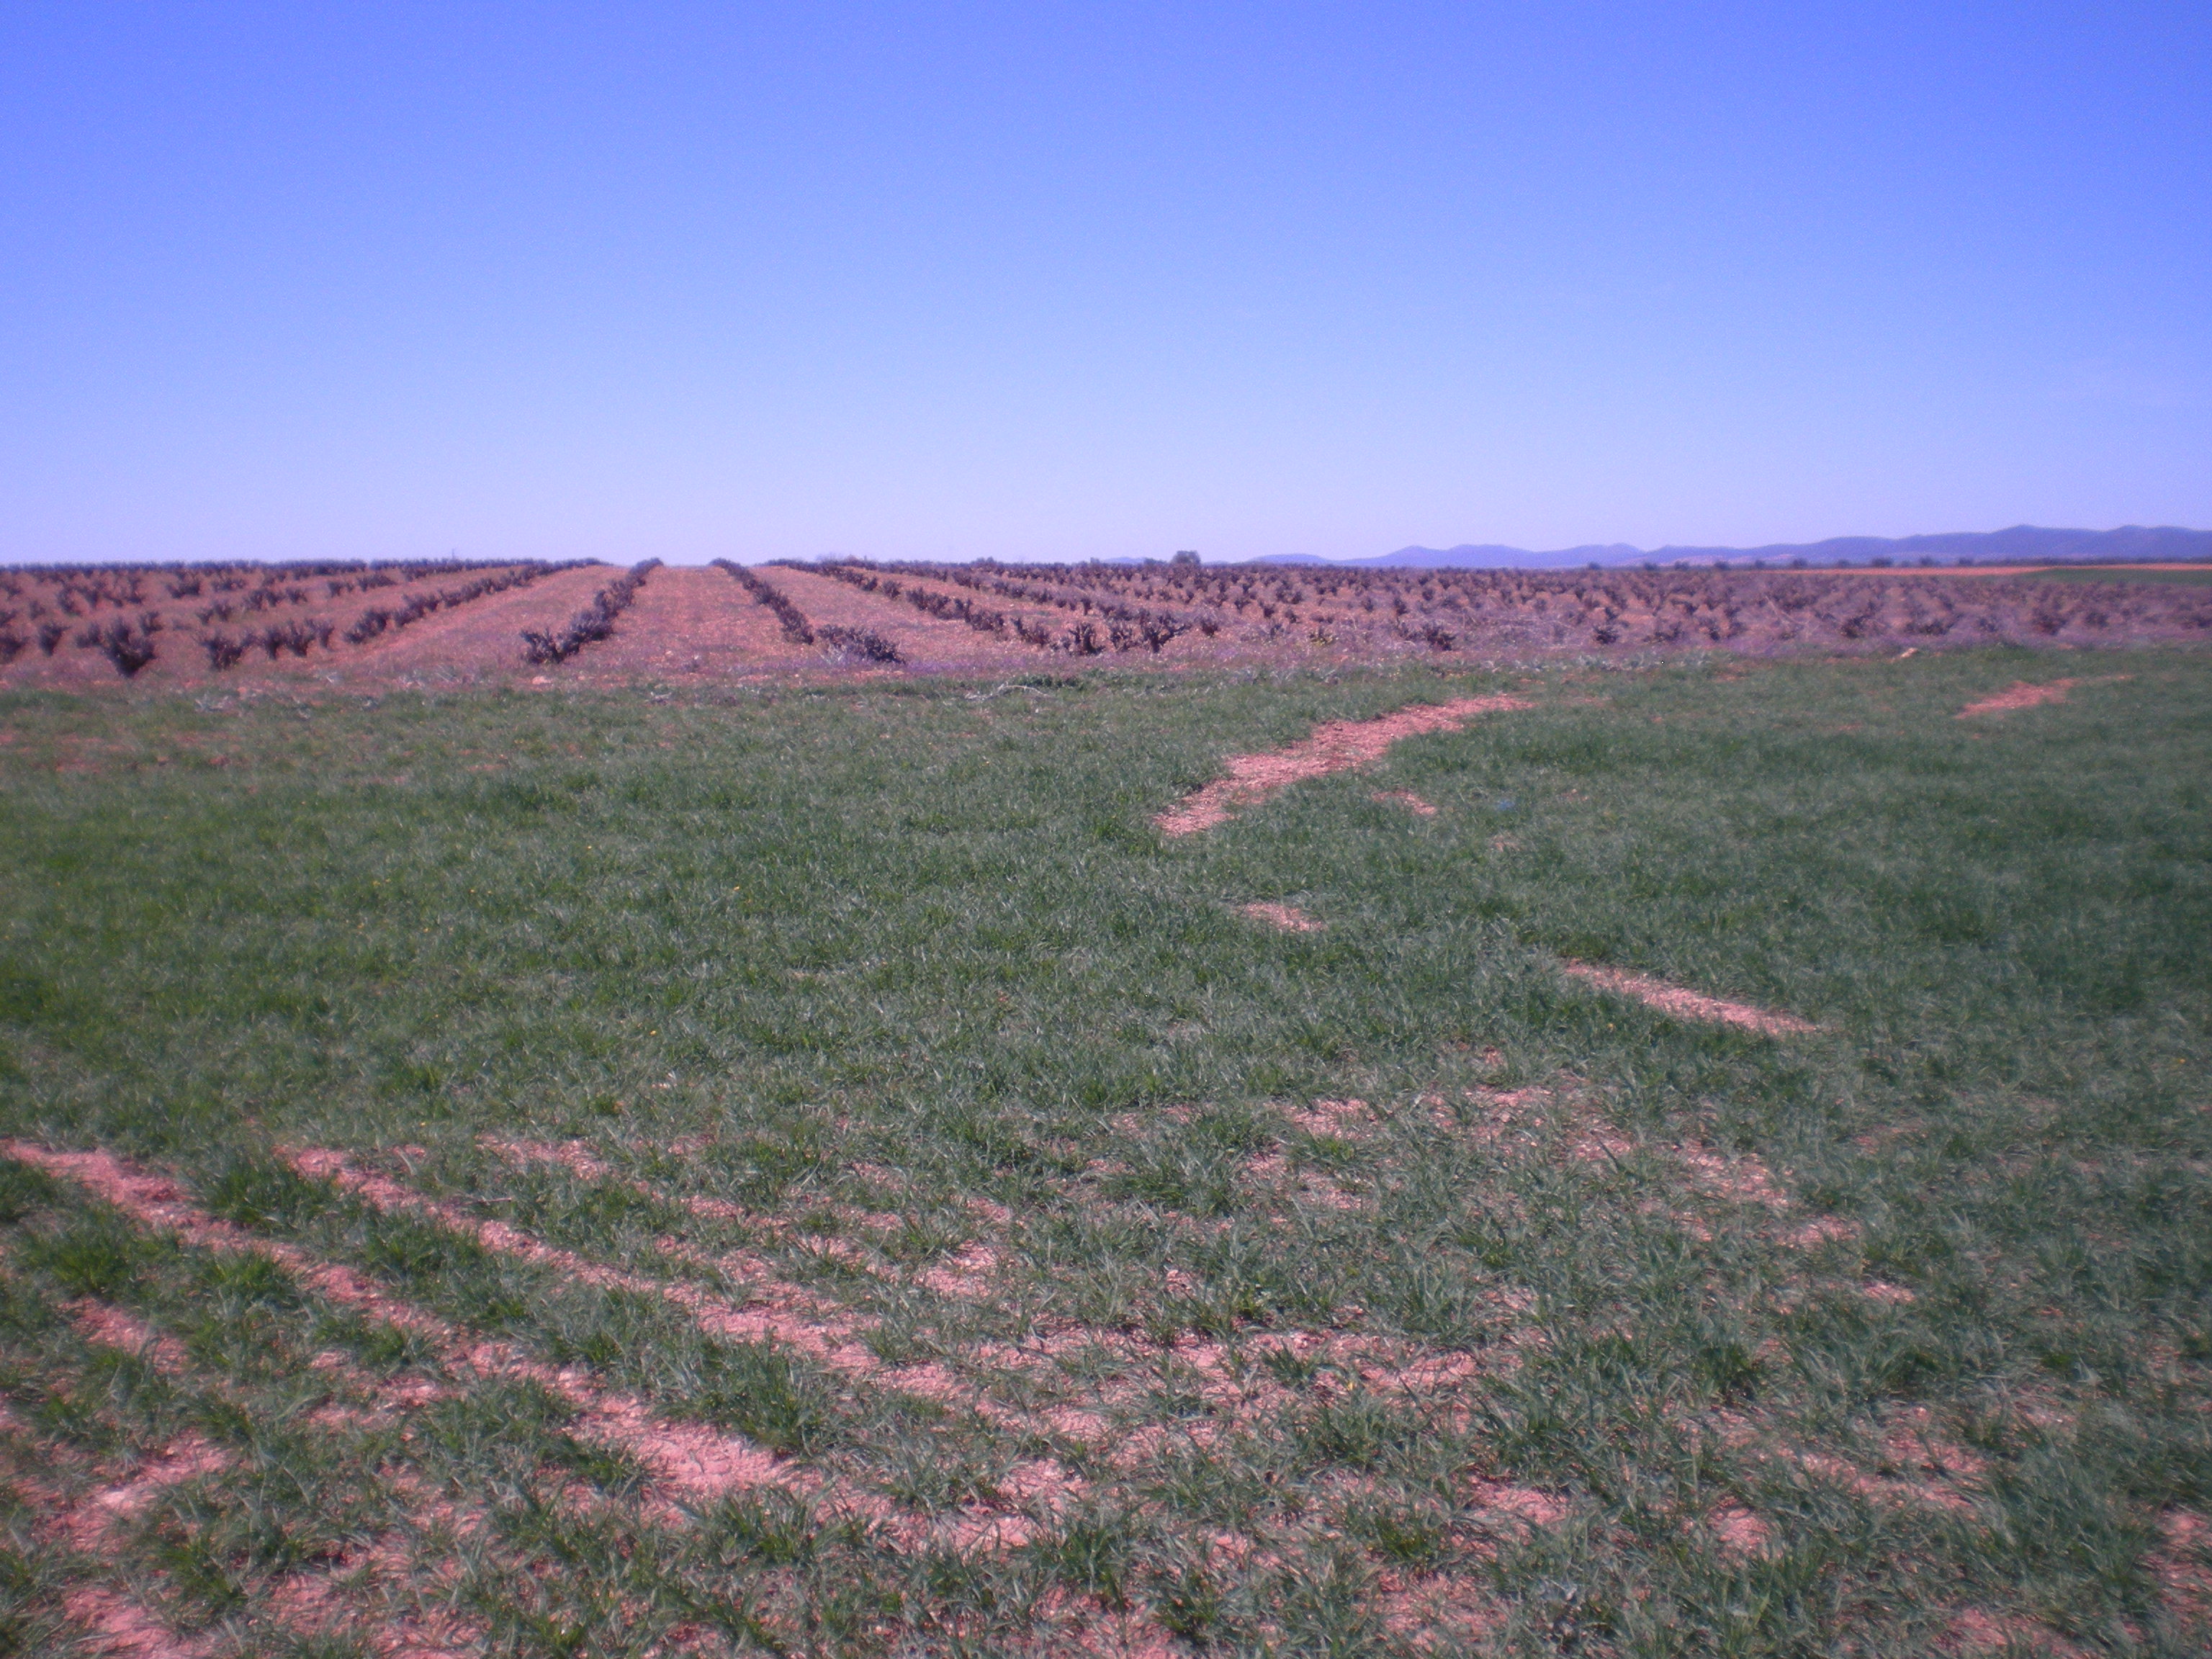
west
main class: Cropland
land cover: Barley
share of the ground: 25 - 50 %
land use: Agriculture (excluding fallow land and kitchen gardens)
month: April
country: ES
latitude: 38.7693
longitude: -3.0478
